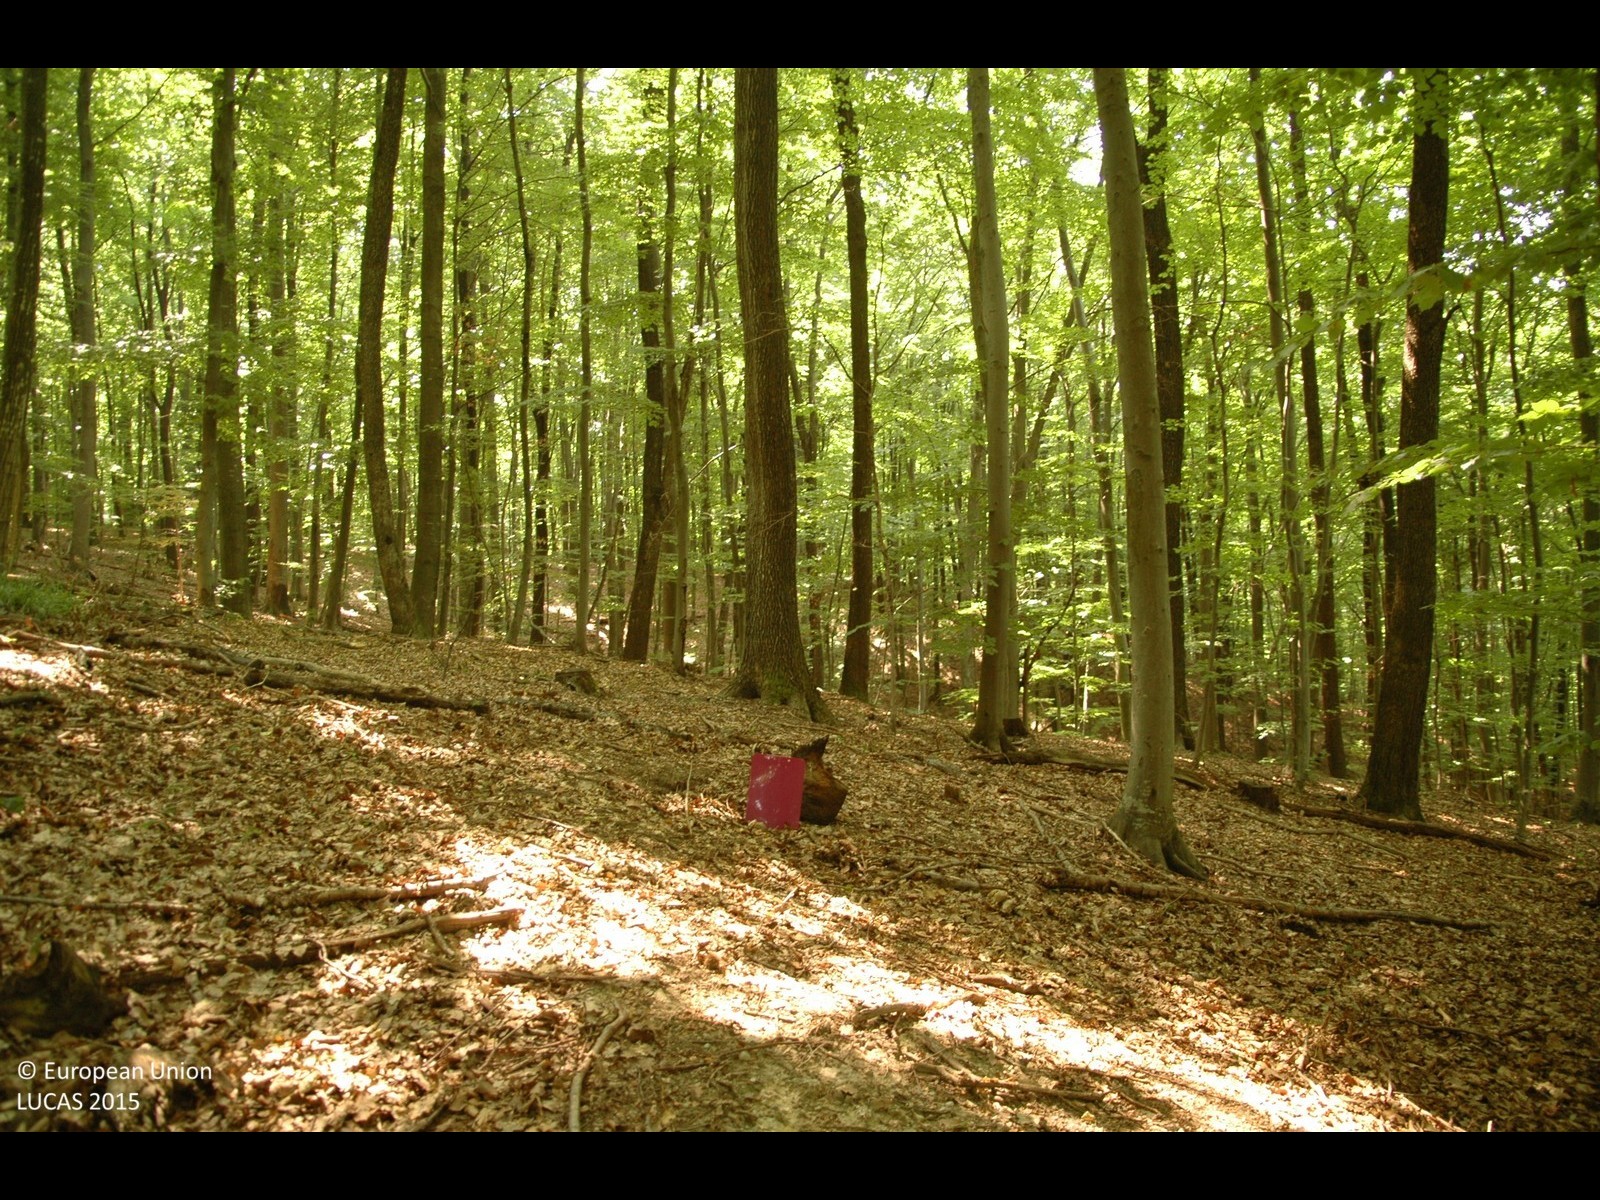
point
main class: Woodland
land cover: Broadleaved woodland
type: mesophytic deciduous forest
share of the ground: > 75 %
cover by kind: broadleaved forest trees 100 %
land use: Forestry
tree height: > 5 m
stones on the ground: < 10 %
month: July
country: HR
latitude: 46.1674
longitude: 16.5668
